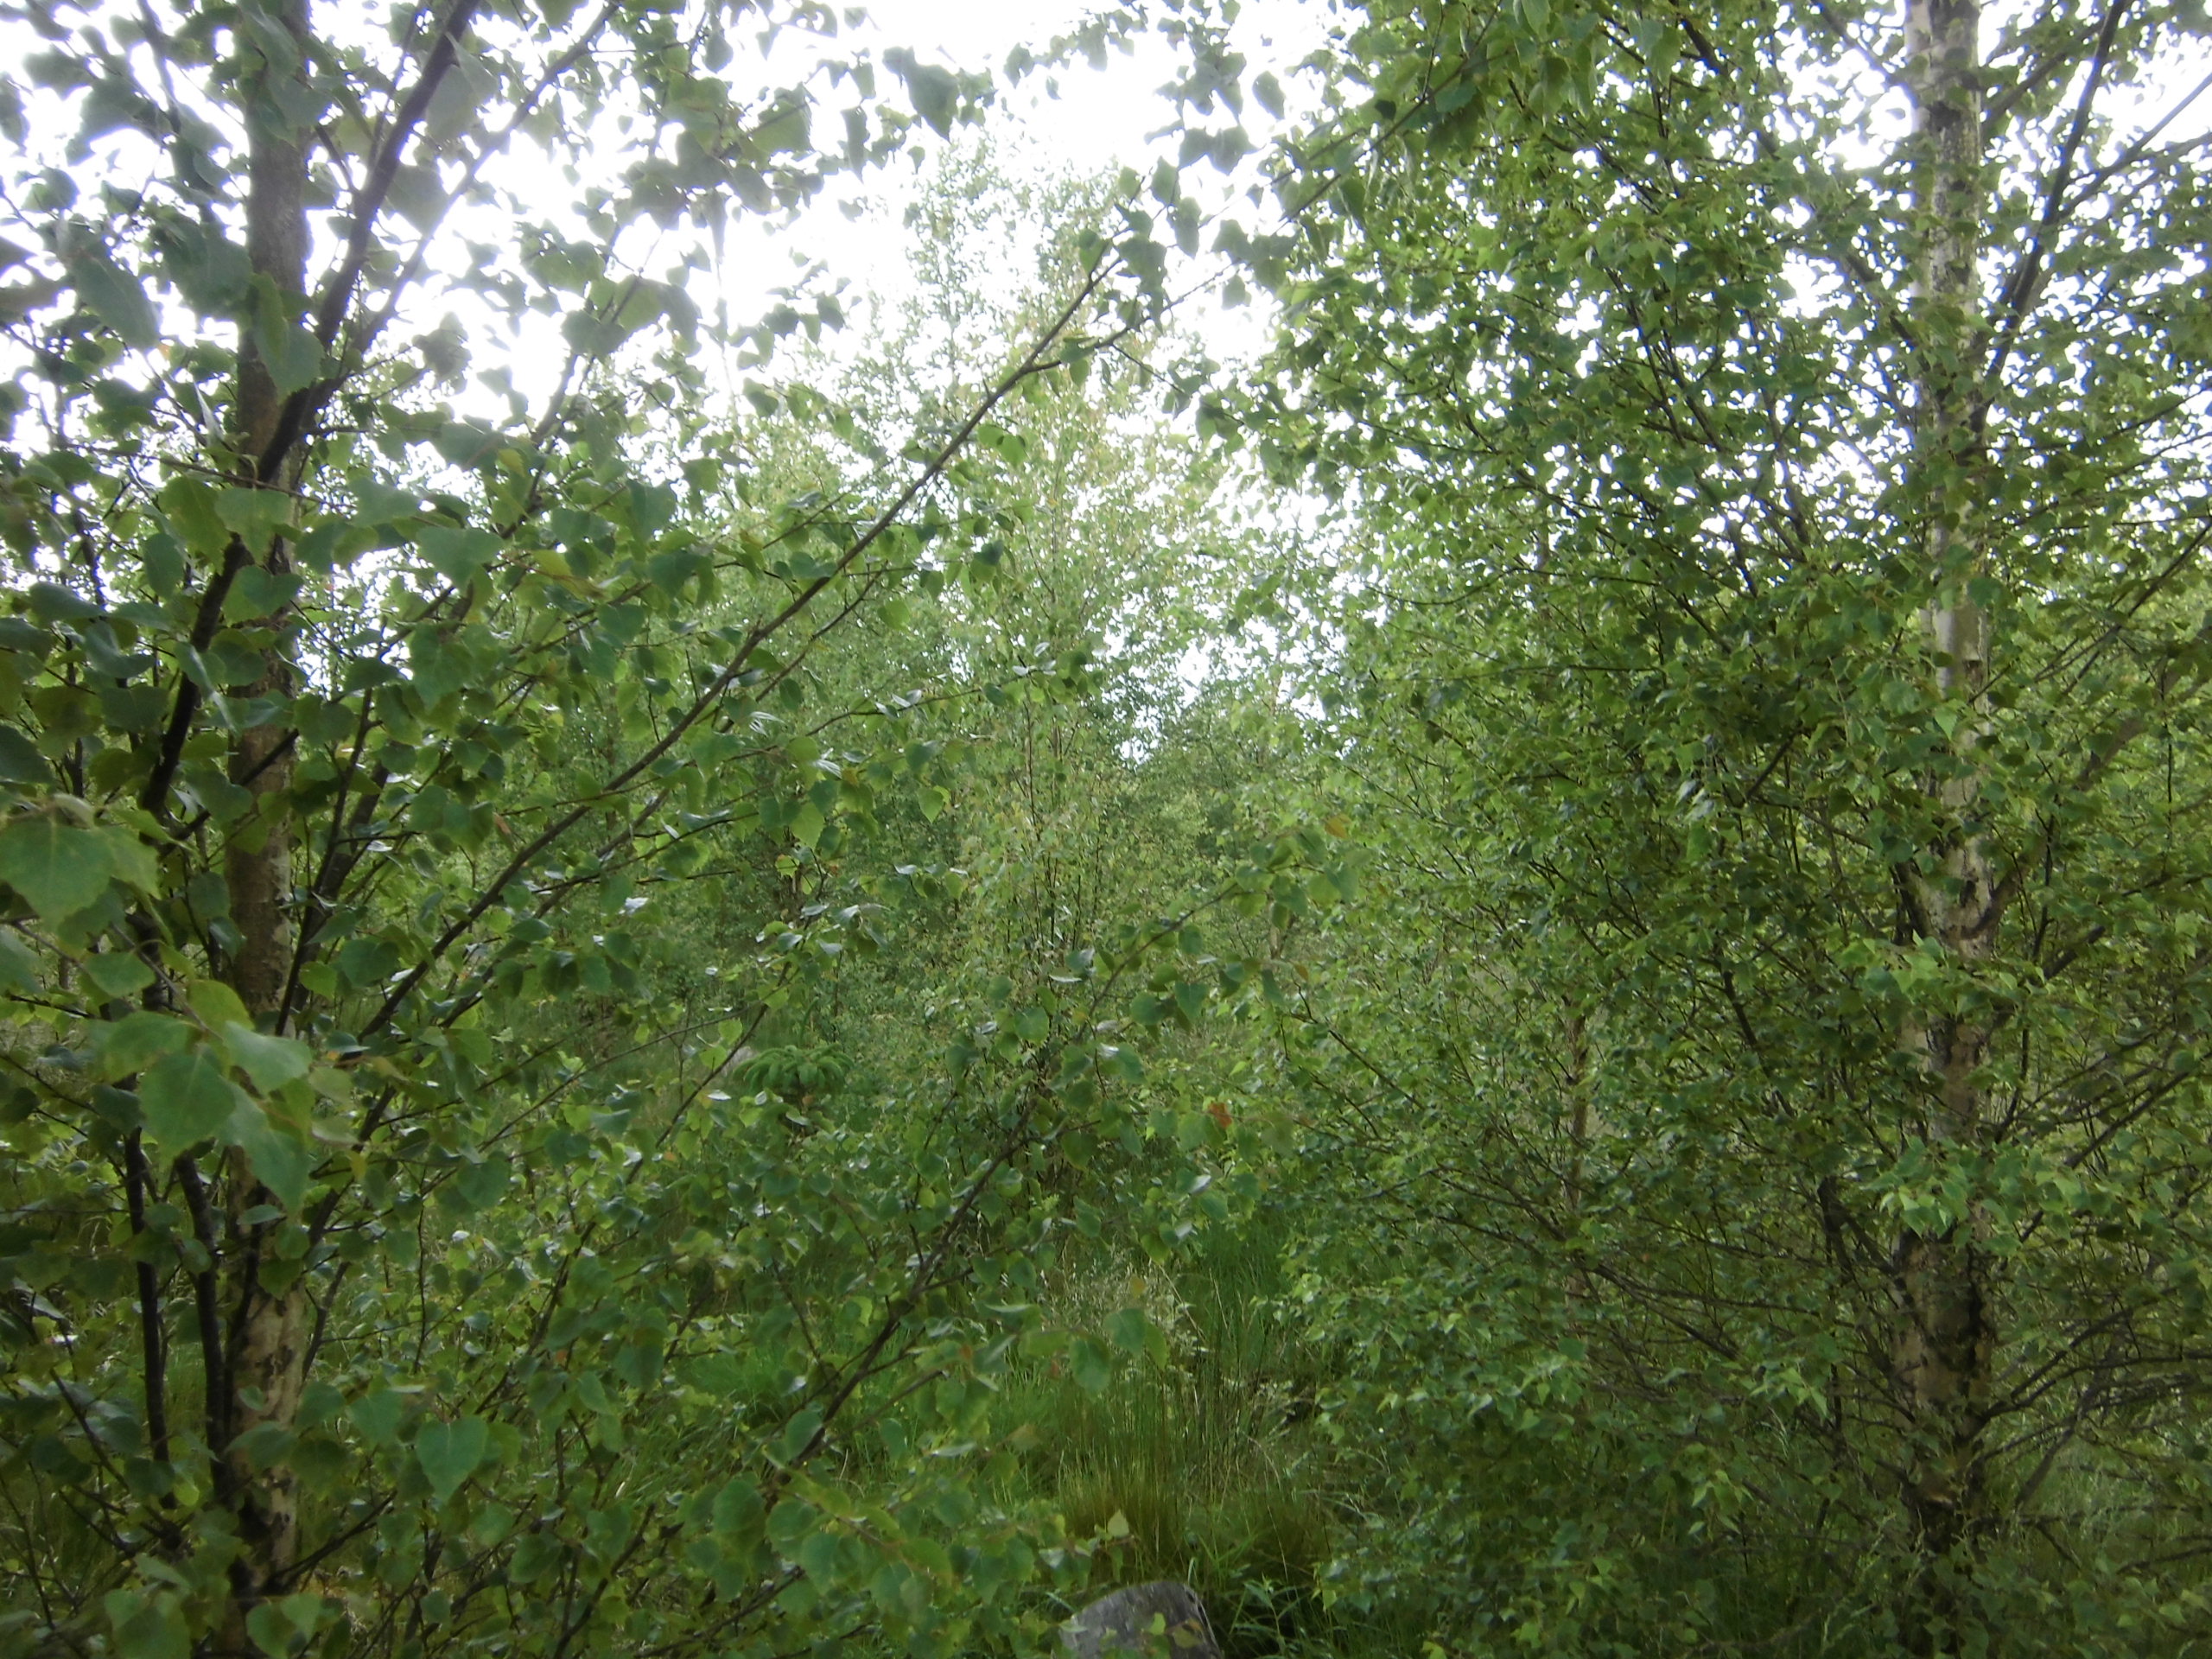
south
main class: Woodland
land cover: Broadleaved woodland
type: boreal forest
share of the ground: 50 - 75 %
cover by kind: broadleaved forest trees 60 %, herbaceous plants 15 %, coniferous forest trees 10 %, shrubs 10 %, lichens and mosses 5 %
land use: Forestry
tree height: < 5 m
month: June
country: SE
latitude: 57.0768
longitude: 14.6321
